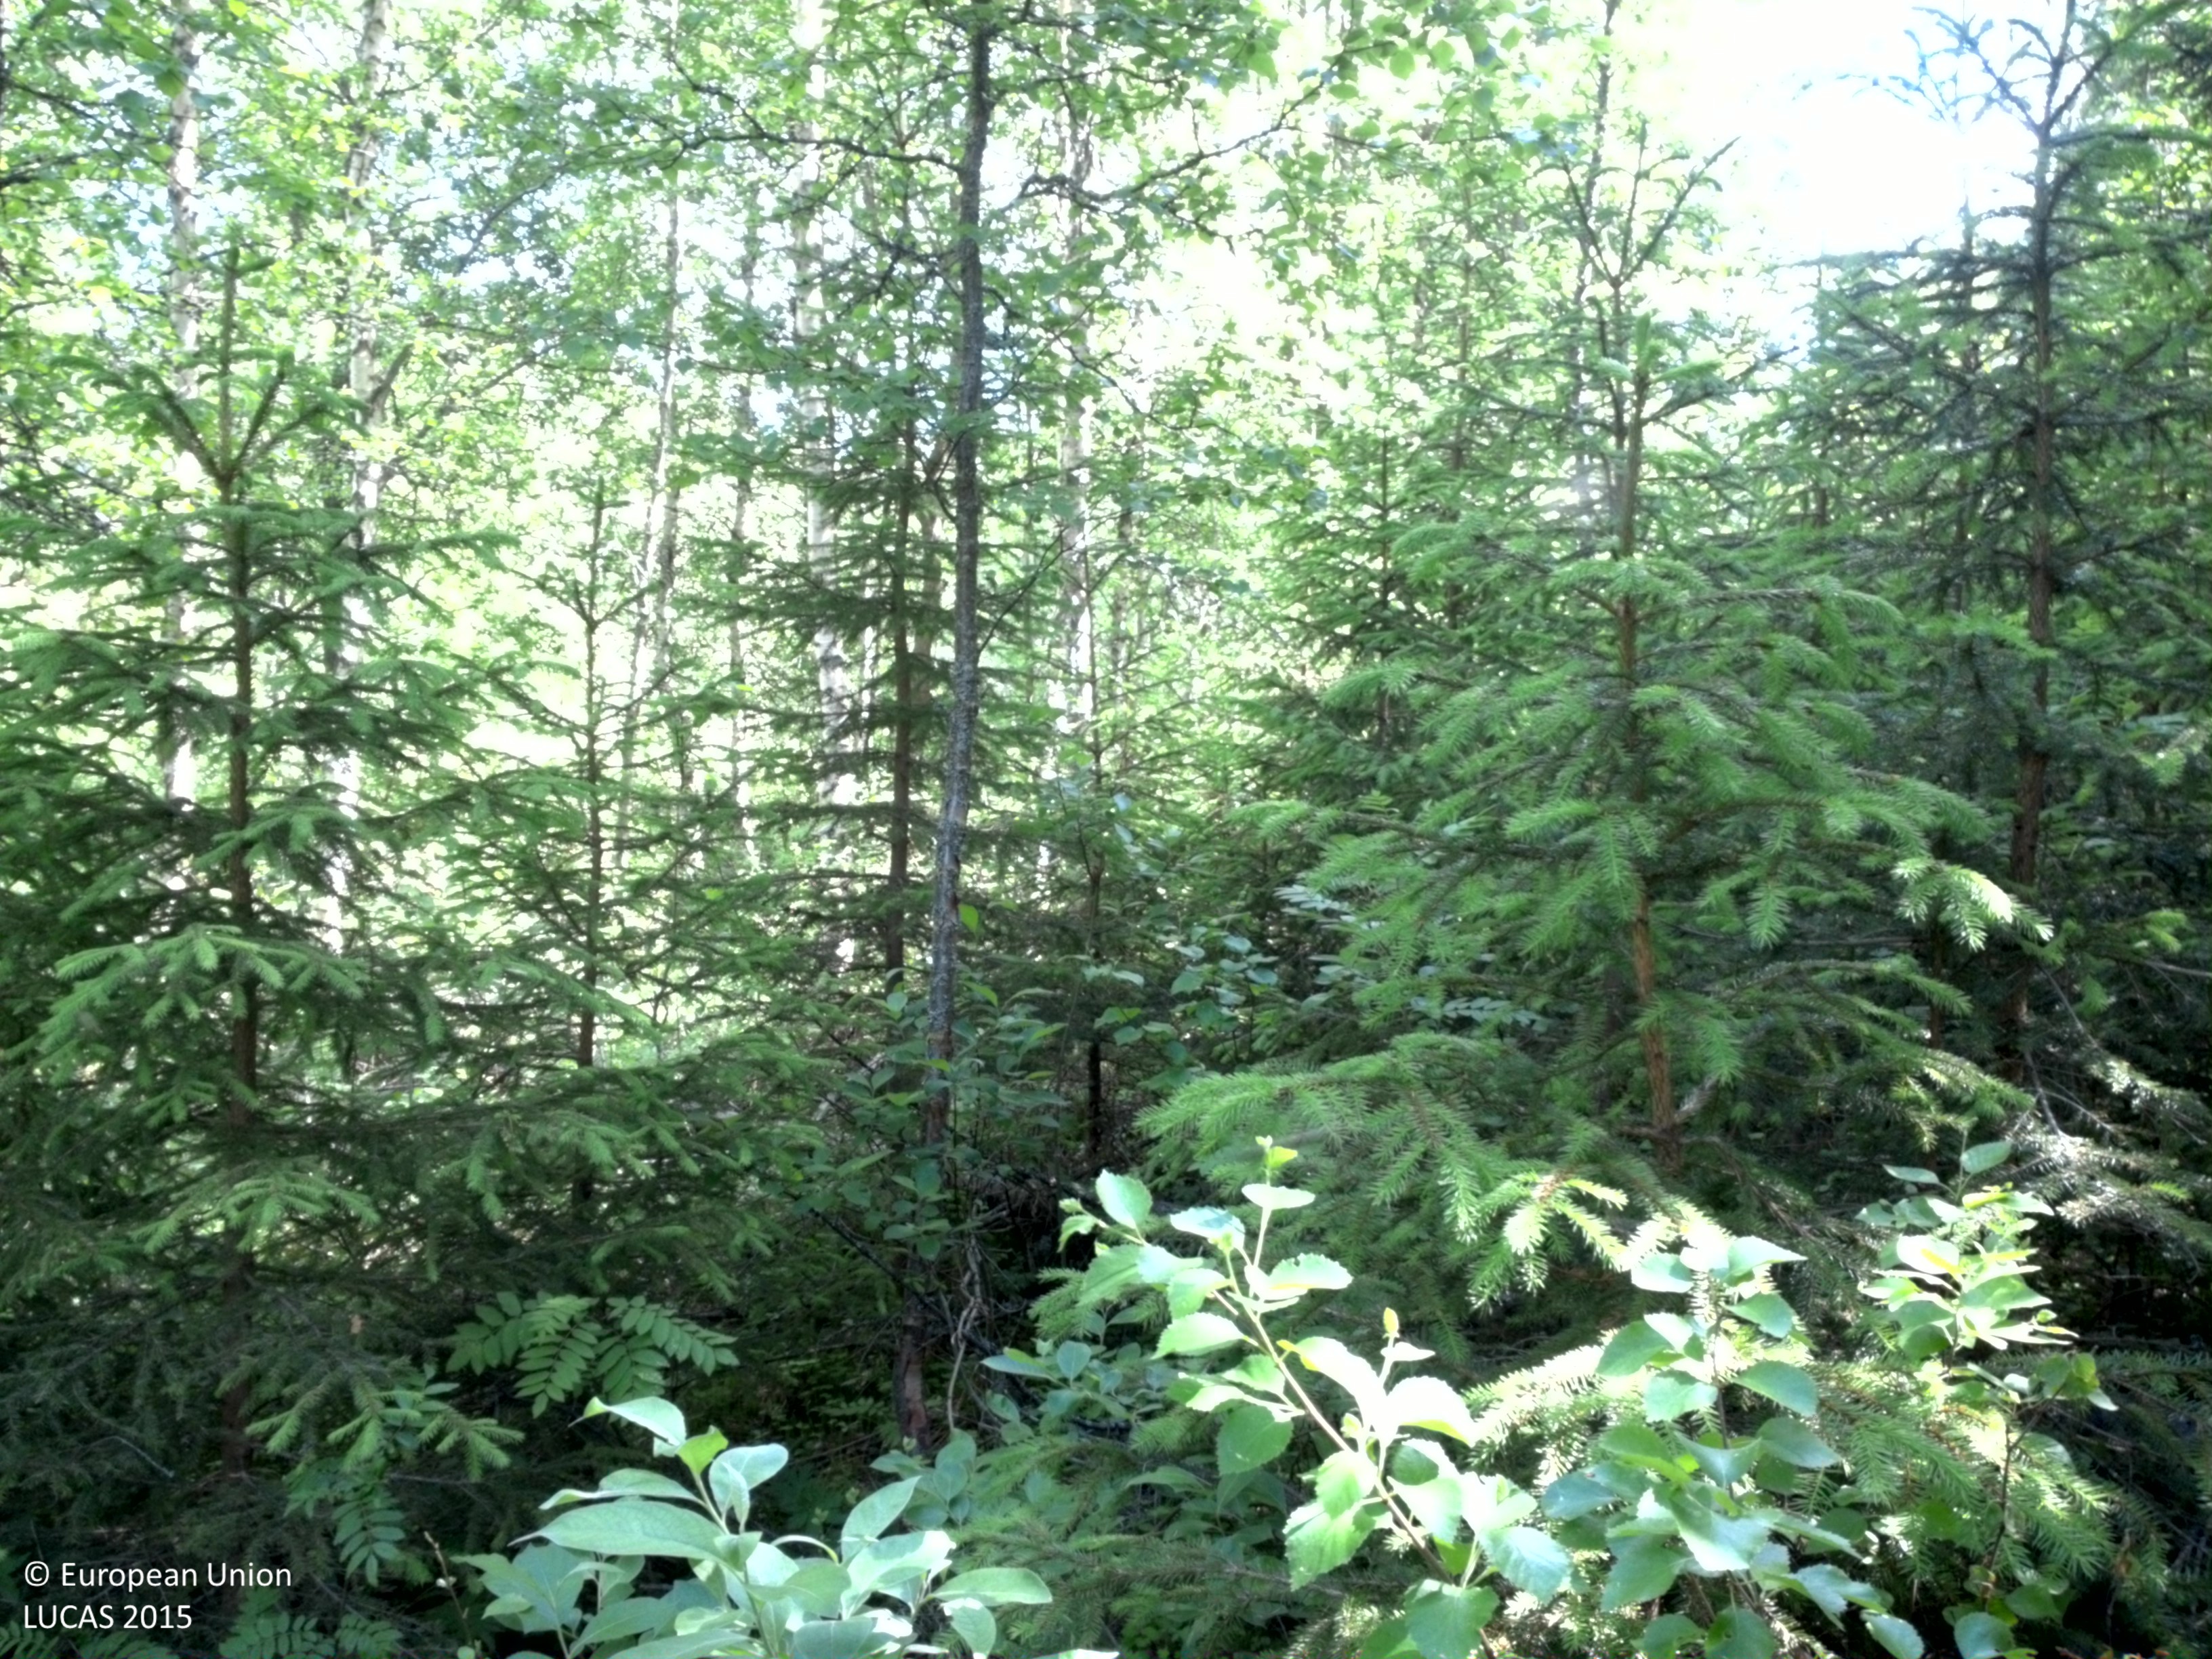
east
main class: Woodland
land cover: Spruce dominated mixed woodland
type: boreal forest
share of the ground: > 75 %
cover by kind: coniferous forest trees 60 %, broadleaved forest trees 20 %, shrubs 10 %, herbaceous plants 10 %
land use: Forestry
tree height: > 5 m
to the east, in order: Spruce dominated mixed woodland; Broadleaved woodland; Shrubland with sparse tree cover; Grassland with sparse tree/shrub cover; Broadleaved woodland; Spruce dominated mixed woodland; Grassland with sparse tree/shrub cover; Tracks; Abandoned hedges; Ditches and canals; Pine dominated coniferous woodland; Shrubland with sparse tree cover; Other bare soil; Other mixed woodland
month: July
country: SE
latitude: 64.3800
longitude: 20.7377
